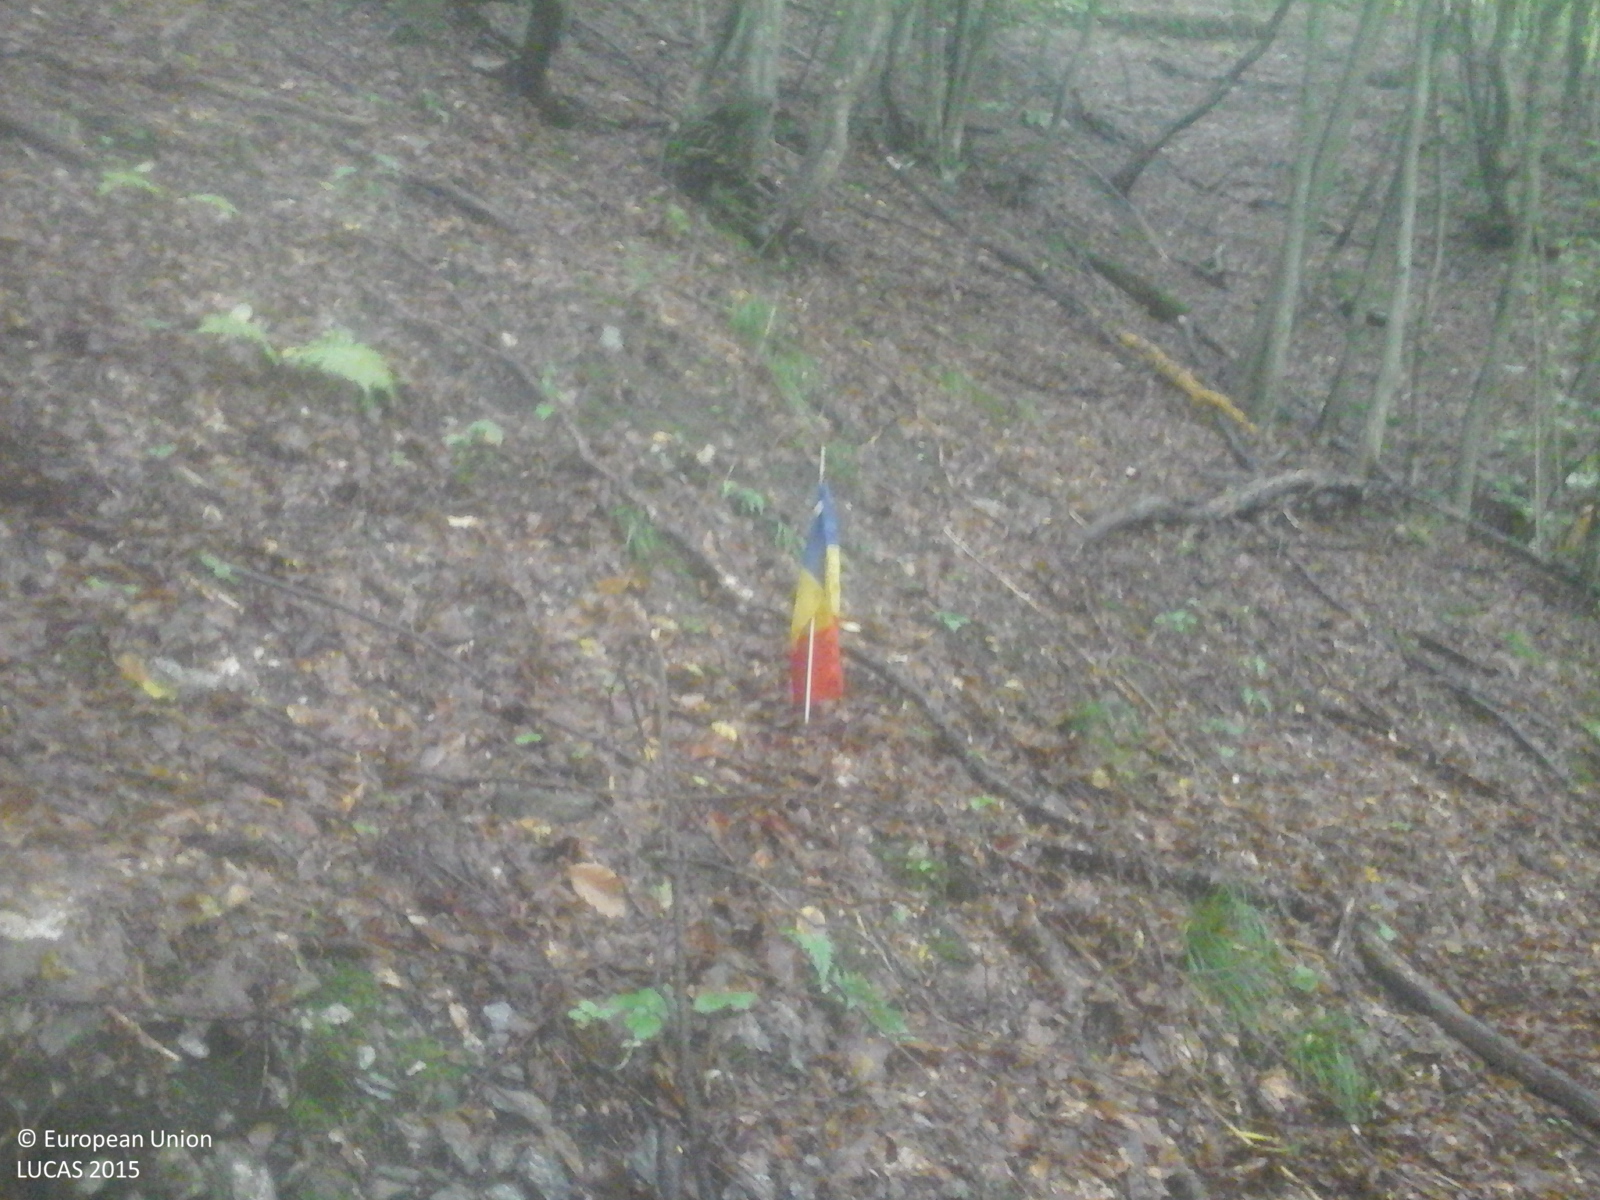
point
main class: Woodland
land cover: Broadleaved woodland
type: beech forest
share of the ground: > 75 %
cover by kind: broadleaved forest trees 100 %
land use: Forestry
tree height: > 5 m
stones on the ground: 10 - 25 %
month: September
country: RO
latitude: 45.8299
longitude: 23.6994
